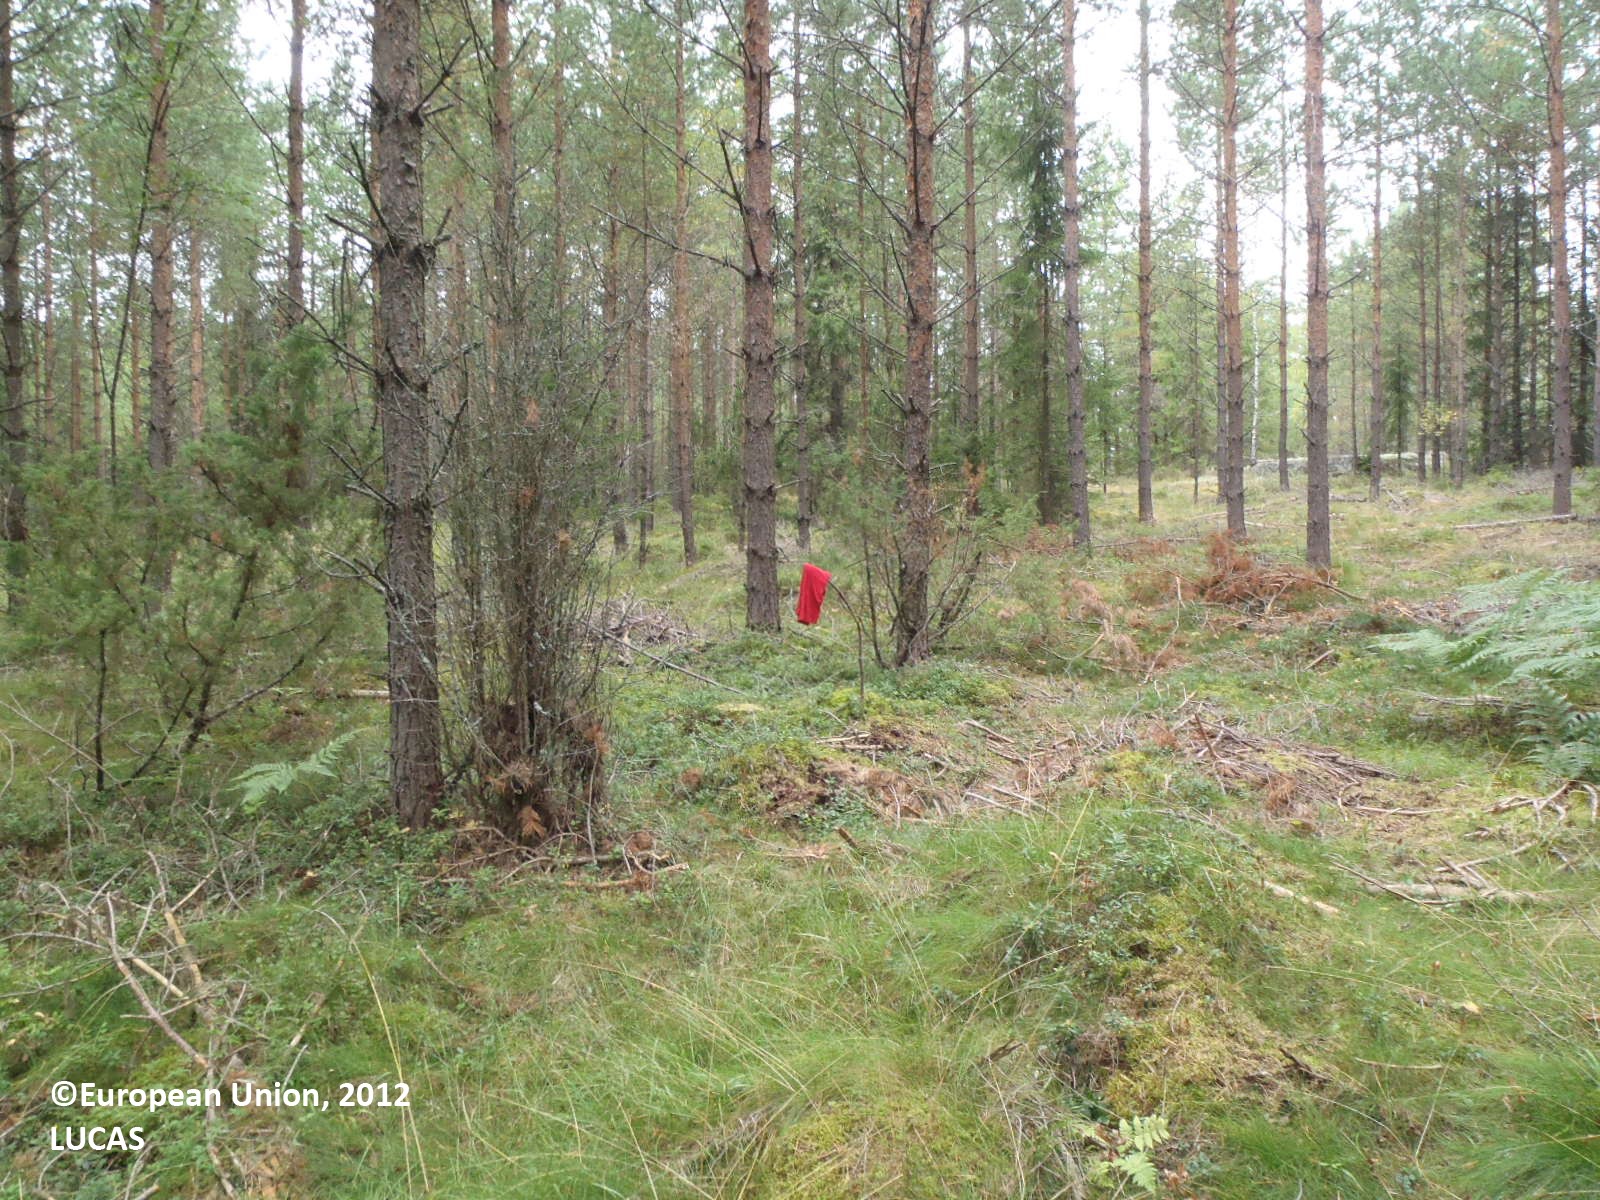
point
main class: Woodland
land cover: Pine dominated coniferous woodland
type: boreal forest
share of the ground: 50 - 75 %
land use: Forestry
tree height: > 5 m
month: September
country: FI
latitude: 60.9800
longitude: 22.8414
